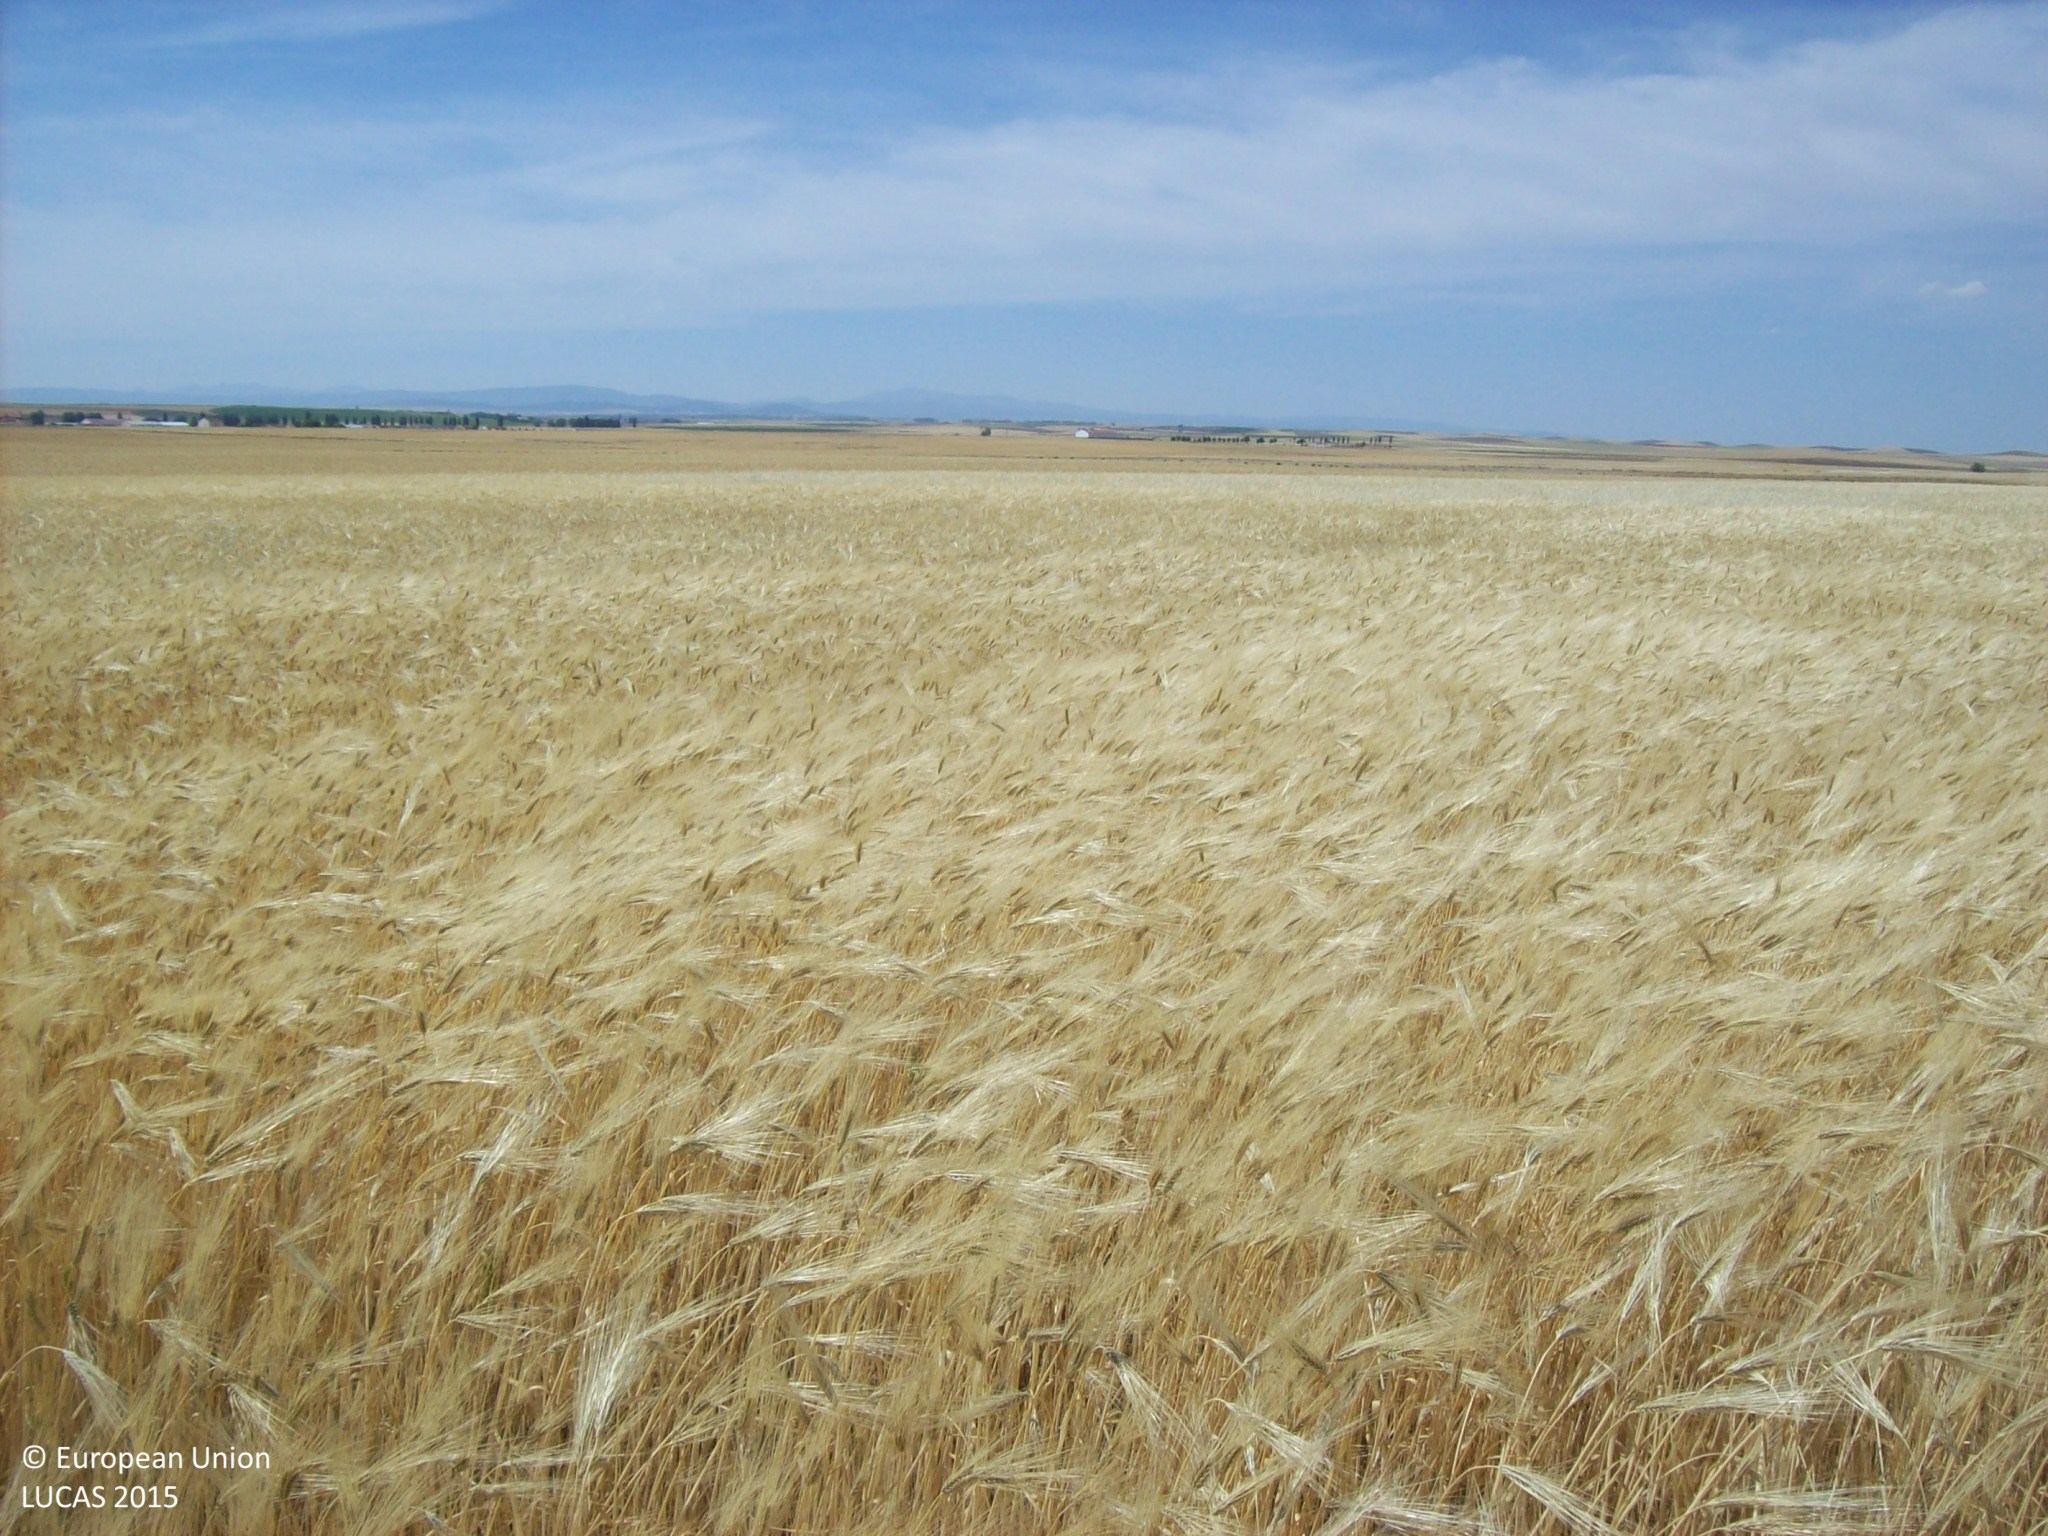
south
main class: Cropland
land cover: Barley
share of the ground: > 75 %
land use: Agriculture (excluding fallow land and kitchen gardens)
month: June
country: ES
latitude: 41.0318
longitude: -5.0171
